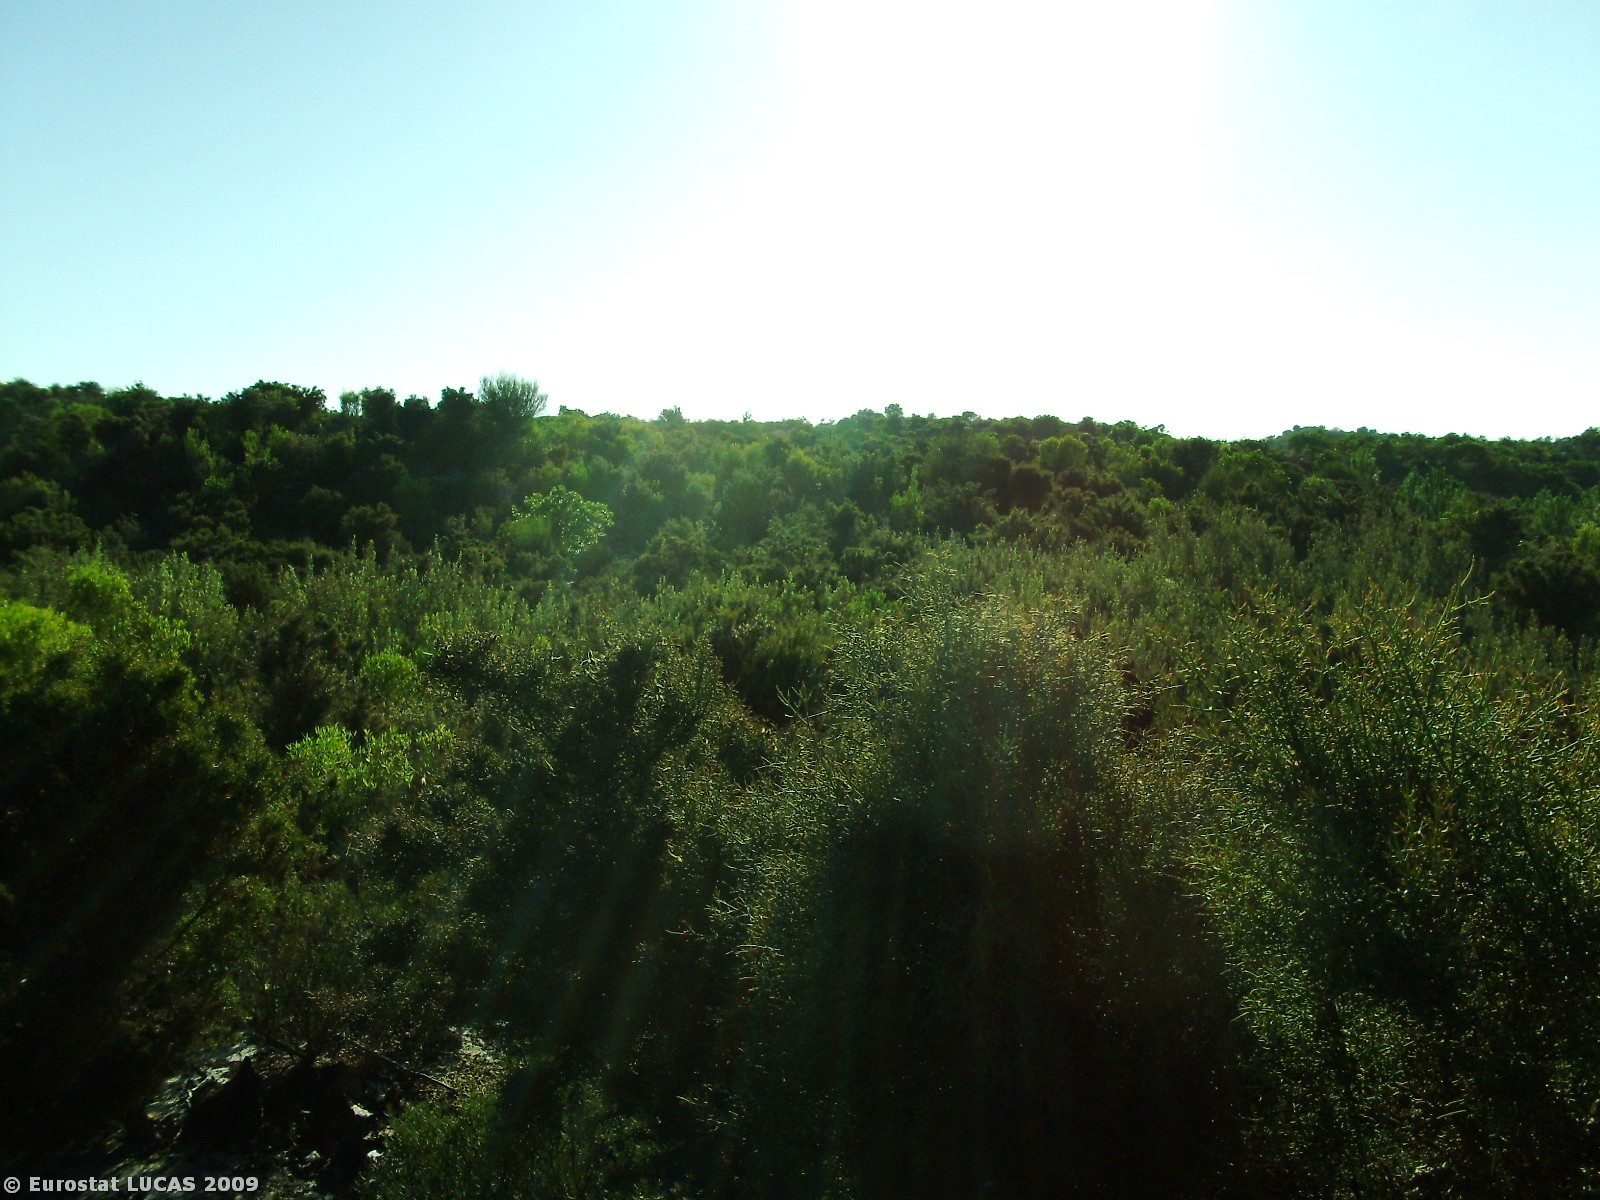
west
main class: Shrubland
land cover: Shrubland without tree cover
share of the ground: > 75 %
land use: Nature reserves
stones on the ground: < 10 %
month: July
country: PT
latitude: 39.8253
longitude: -8.9608
